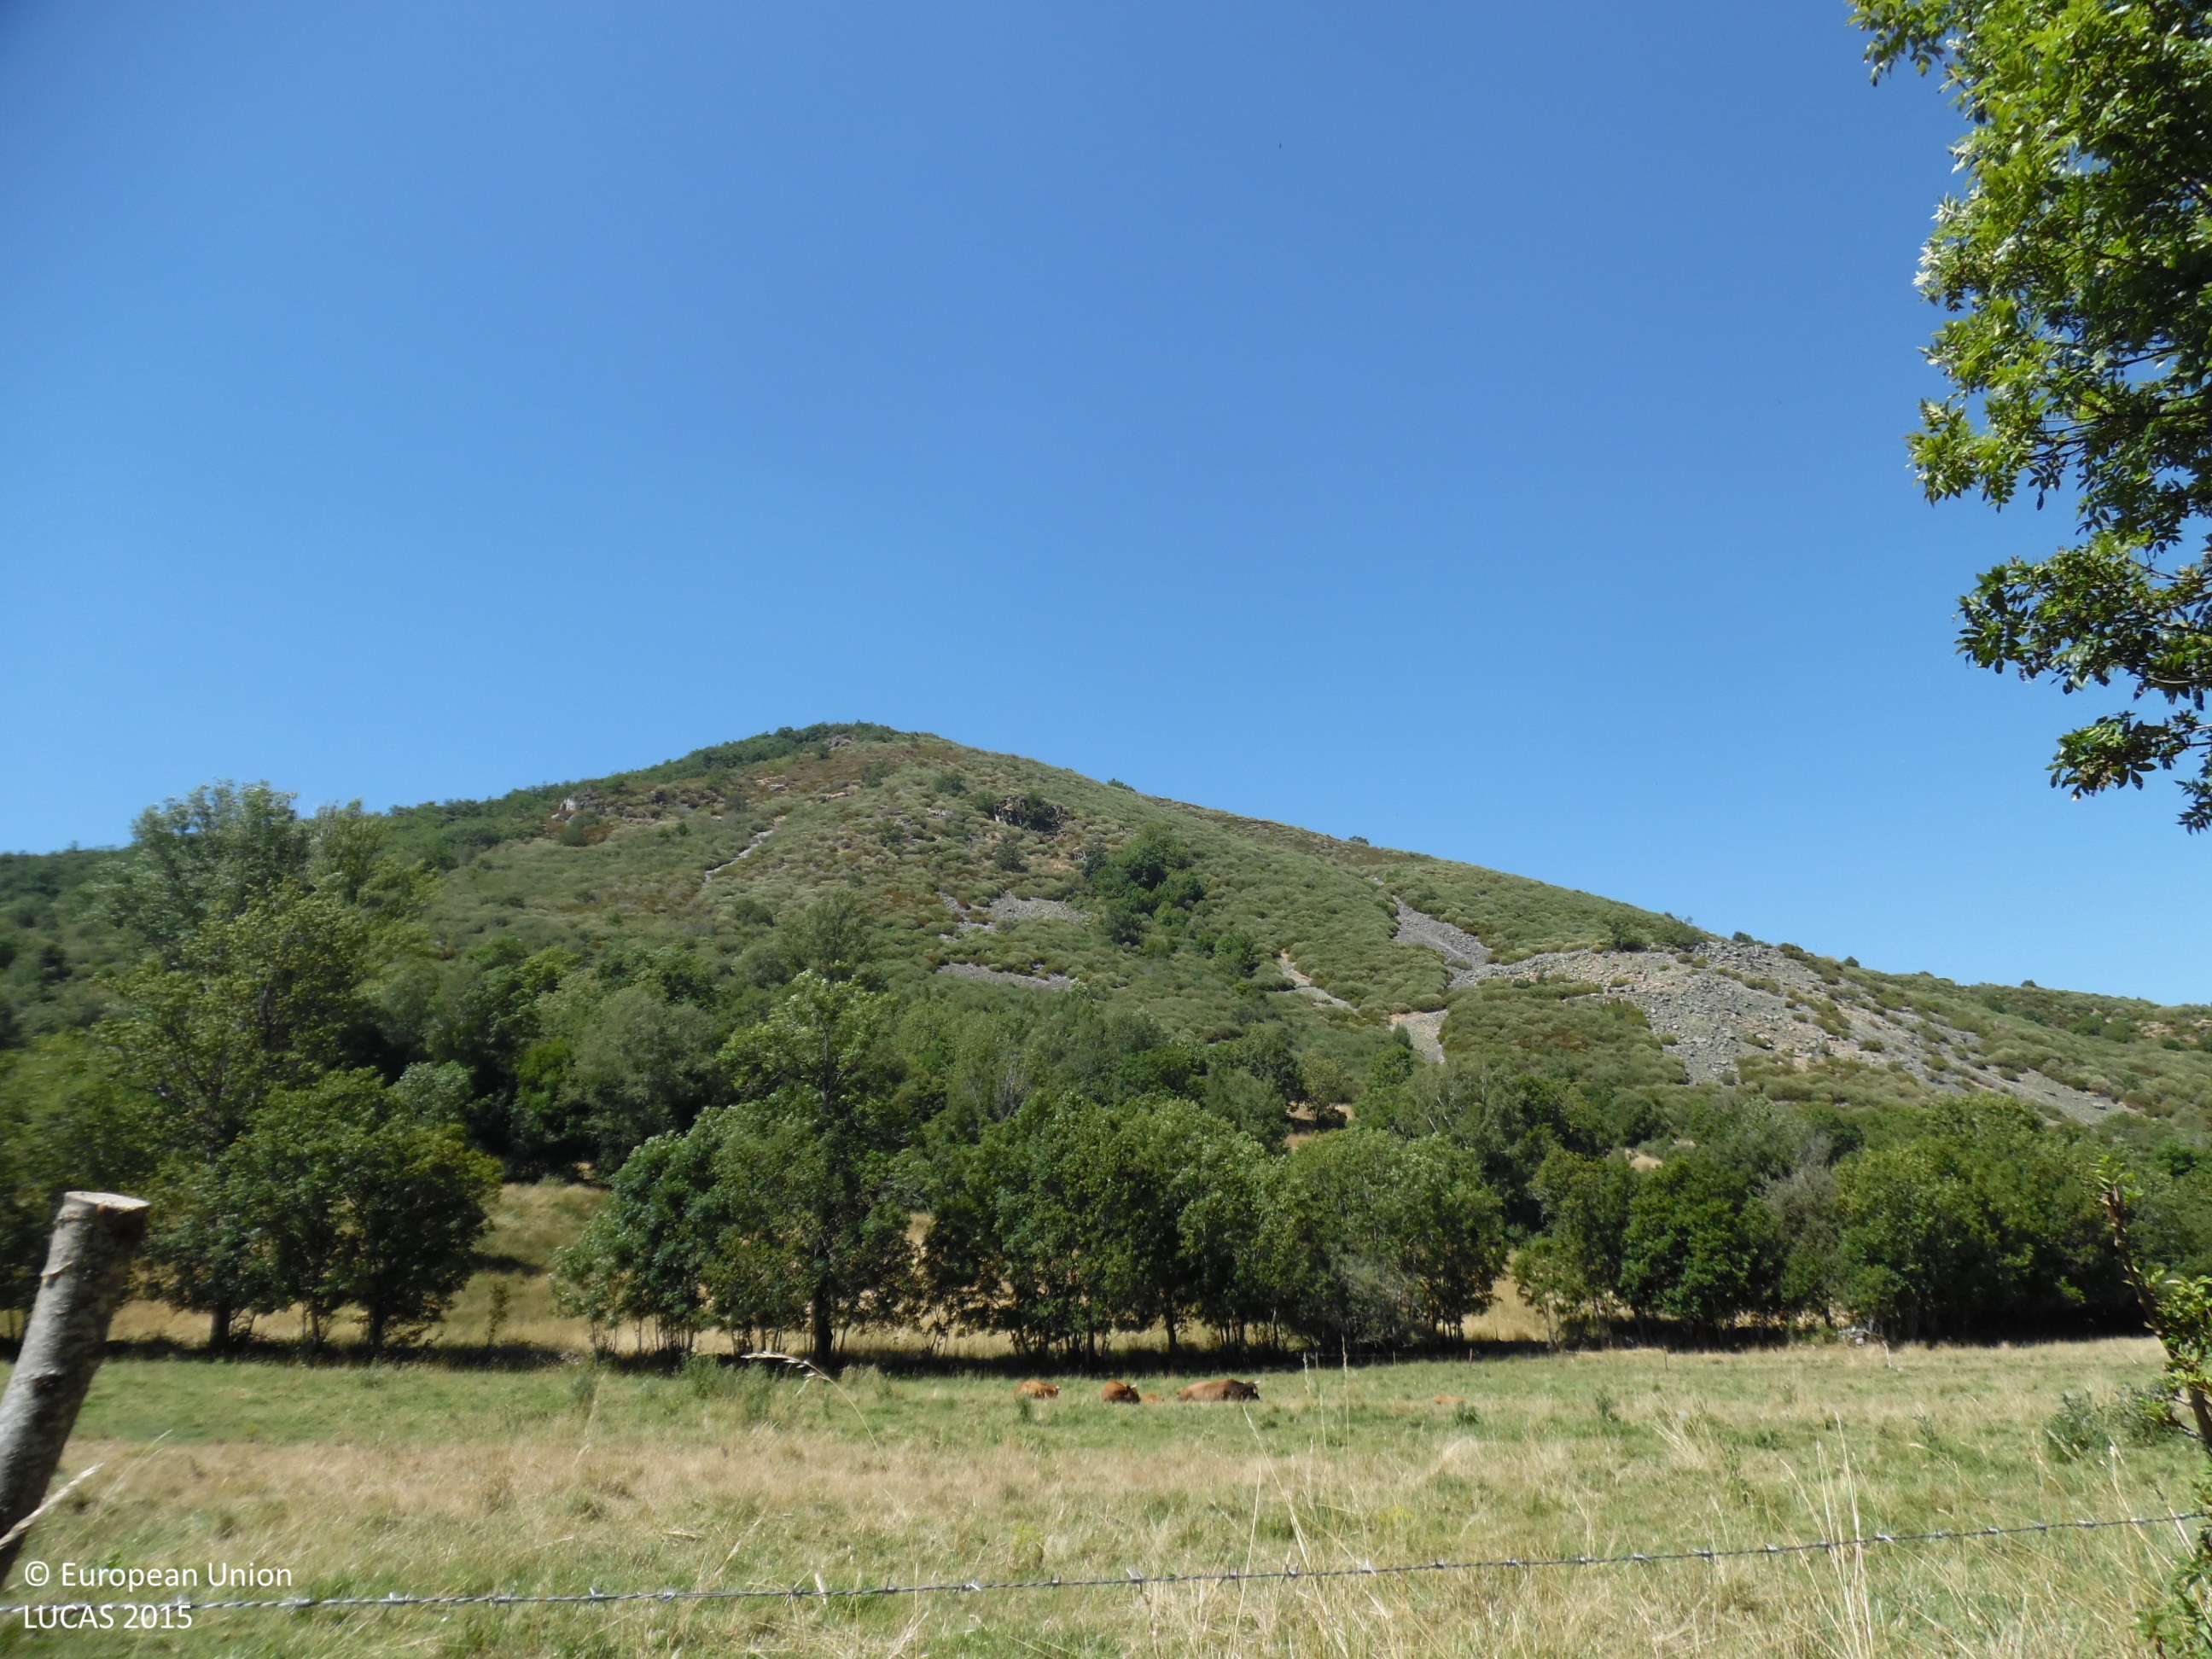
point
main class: Shrubland
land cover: Shrubland without tree cover
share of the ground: > 75 %
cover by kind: shrubs 100 %
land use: Semi-natural and natural areas not in use
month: August
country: ES
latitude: 42.7933
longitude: -6.1902
